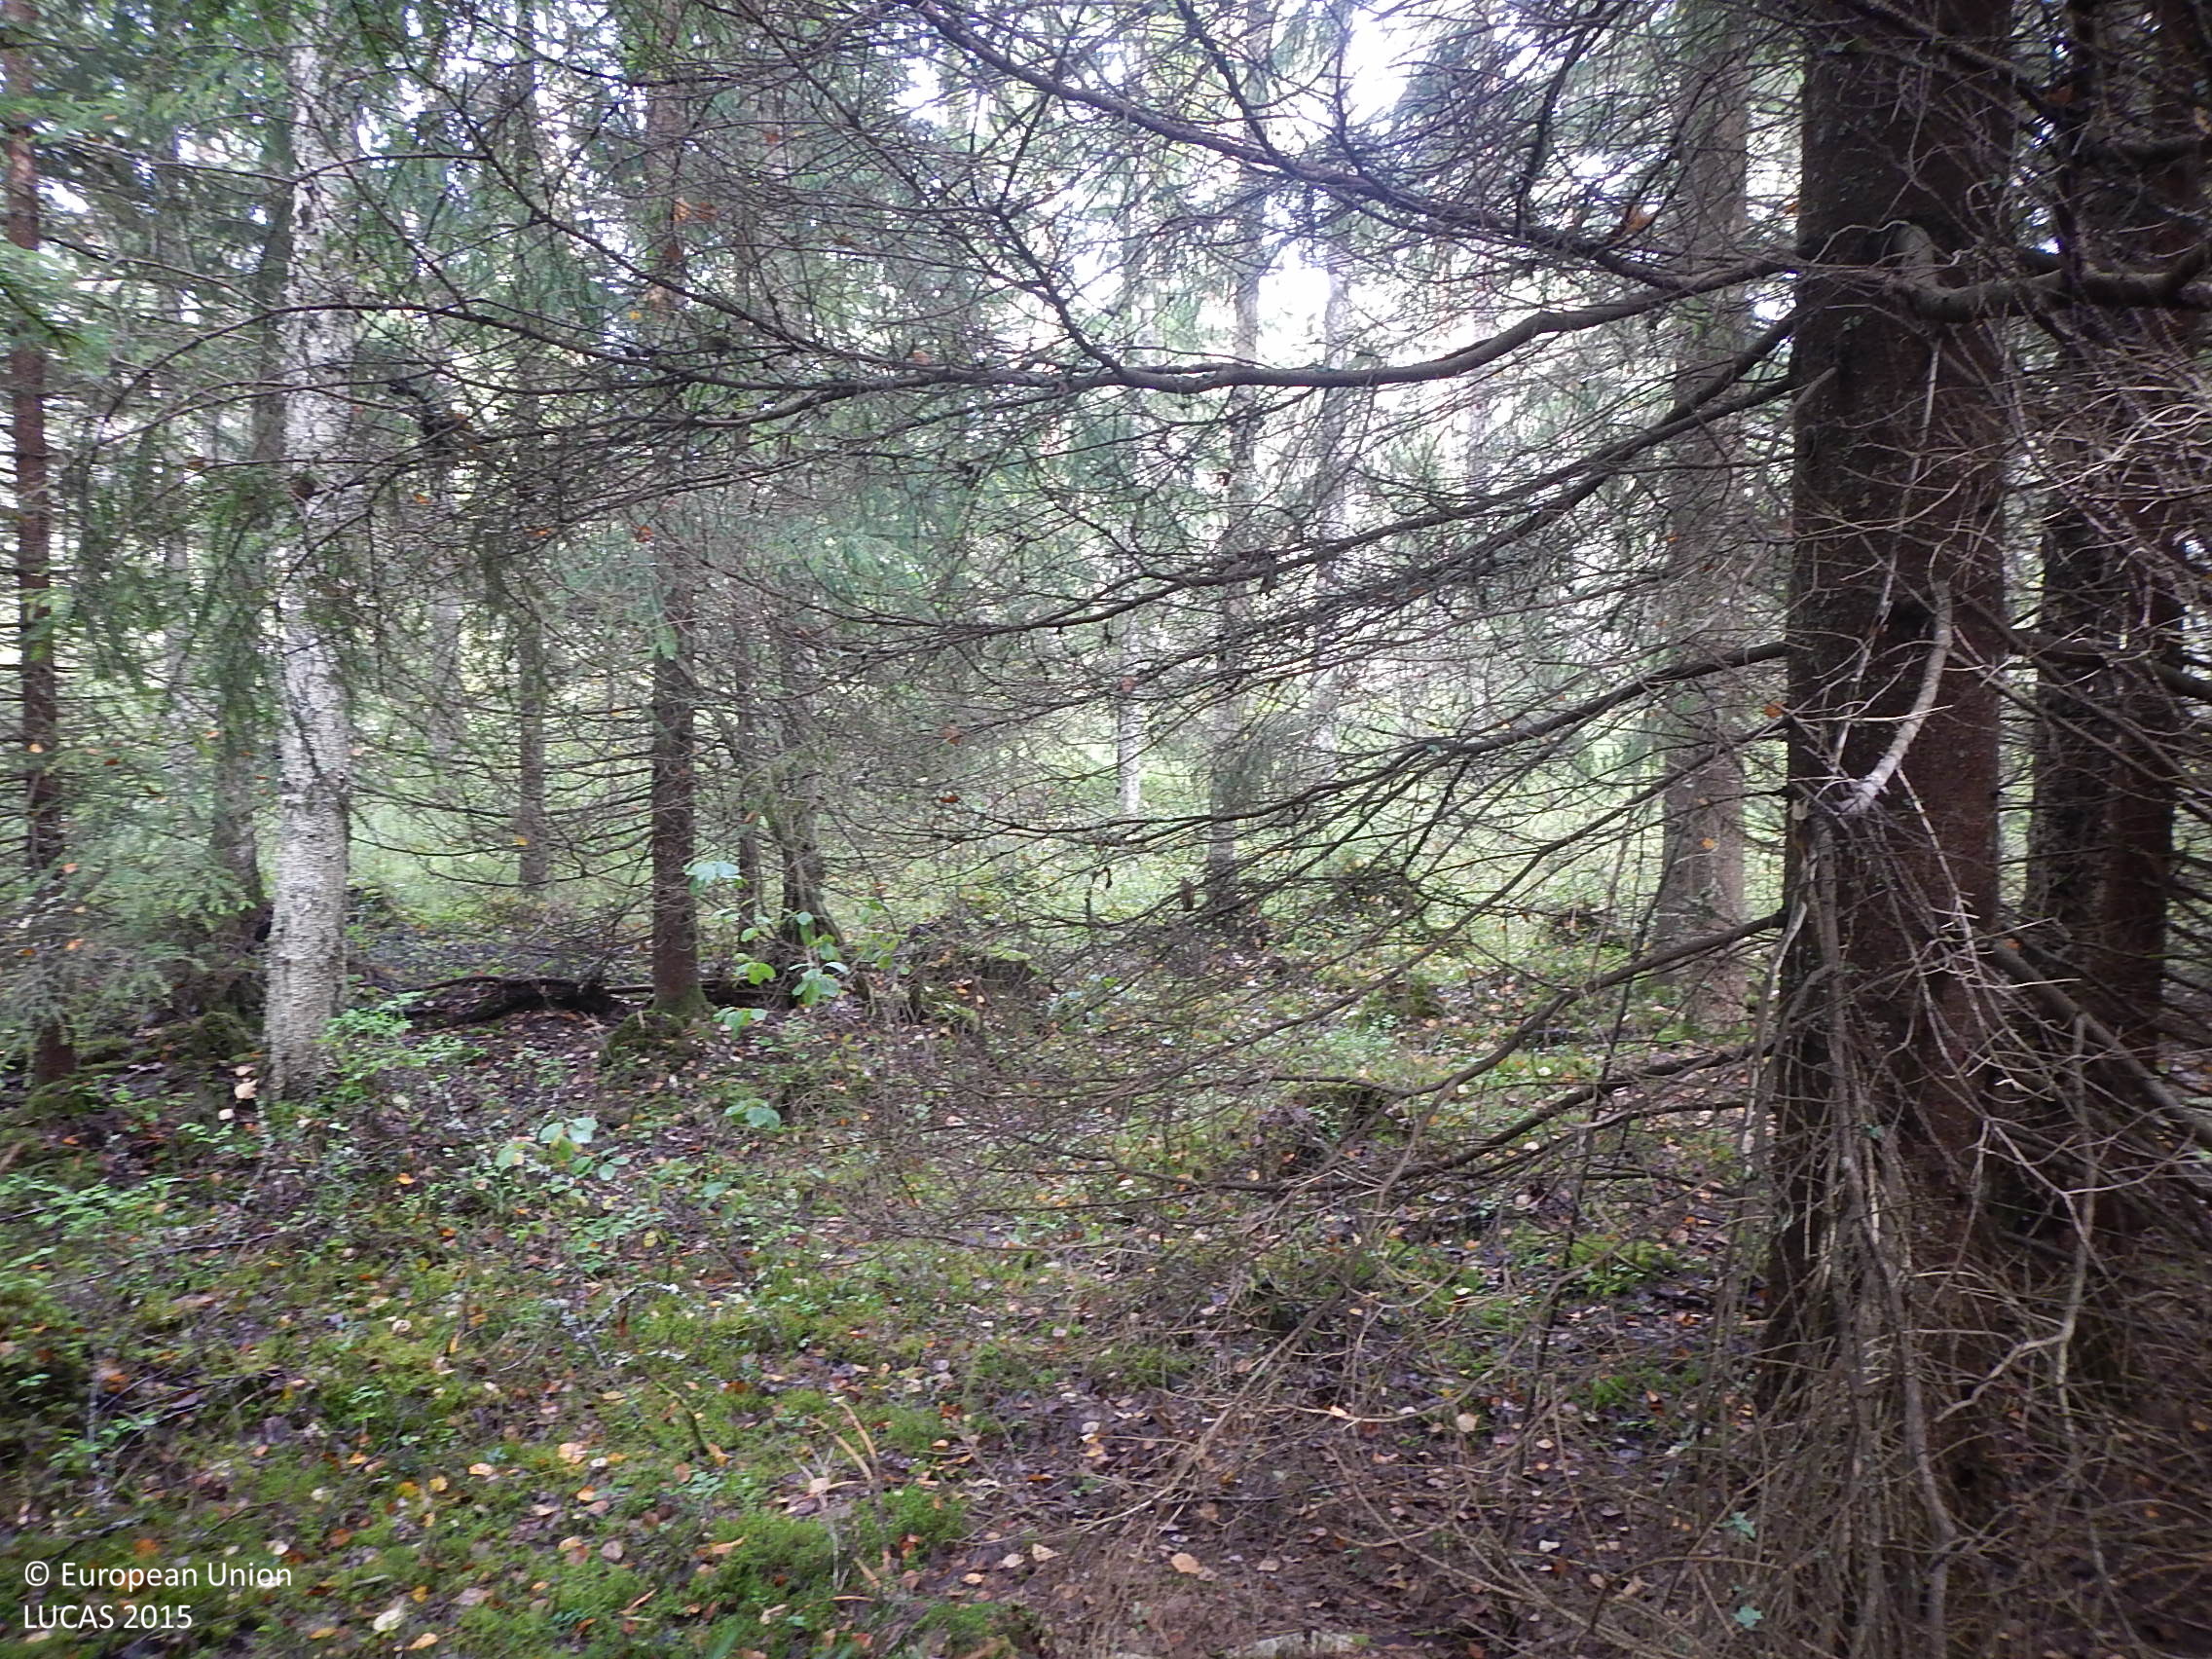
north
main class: Woodland
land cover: Other mixed woodland
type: boreal forest
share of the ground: > 75 %
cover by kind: coniferous forest trees 65 %, broadleaved forest trees 30 %, lichens and mosses 5 %
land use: Forestry
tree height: > 5 m
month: September
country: FI
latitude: 61.4566
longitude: 23.0355
